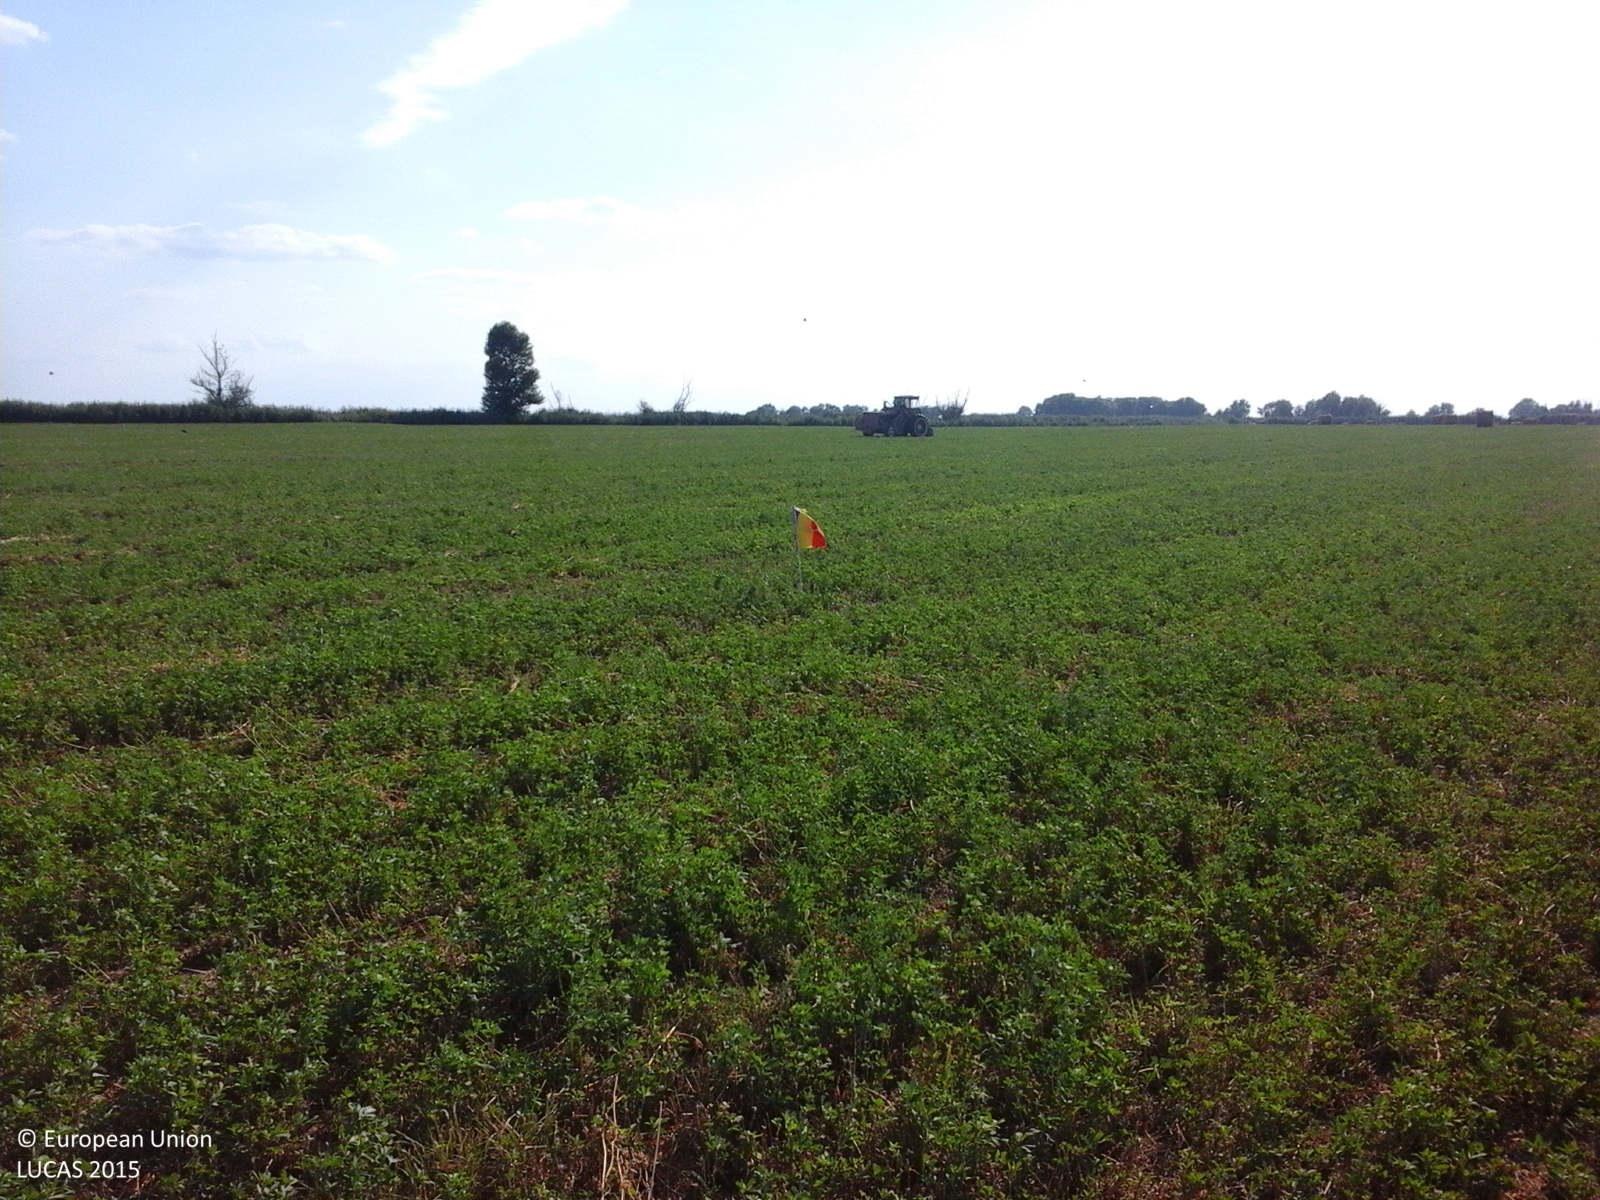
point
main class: Cropland
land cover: Lucerne
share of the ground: > 75 %
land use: Agriculture (excluding fallow land and kitchen gardens)
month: August
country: RO
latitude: 45.3509
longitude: 29.1875
